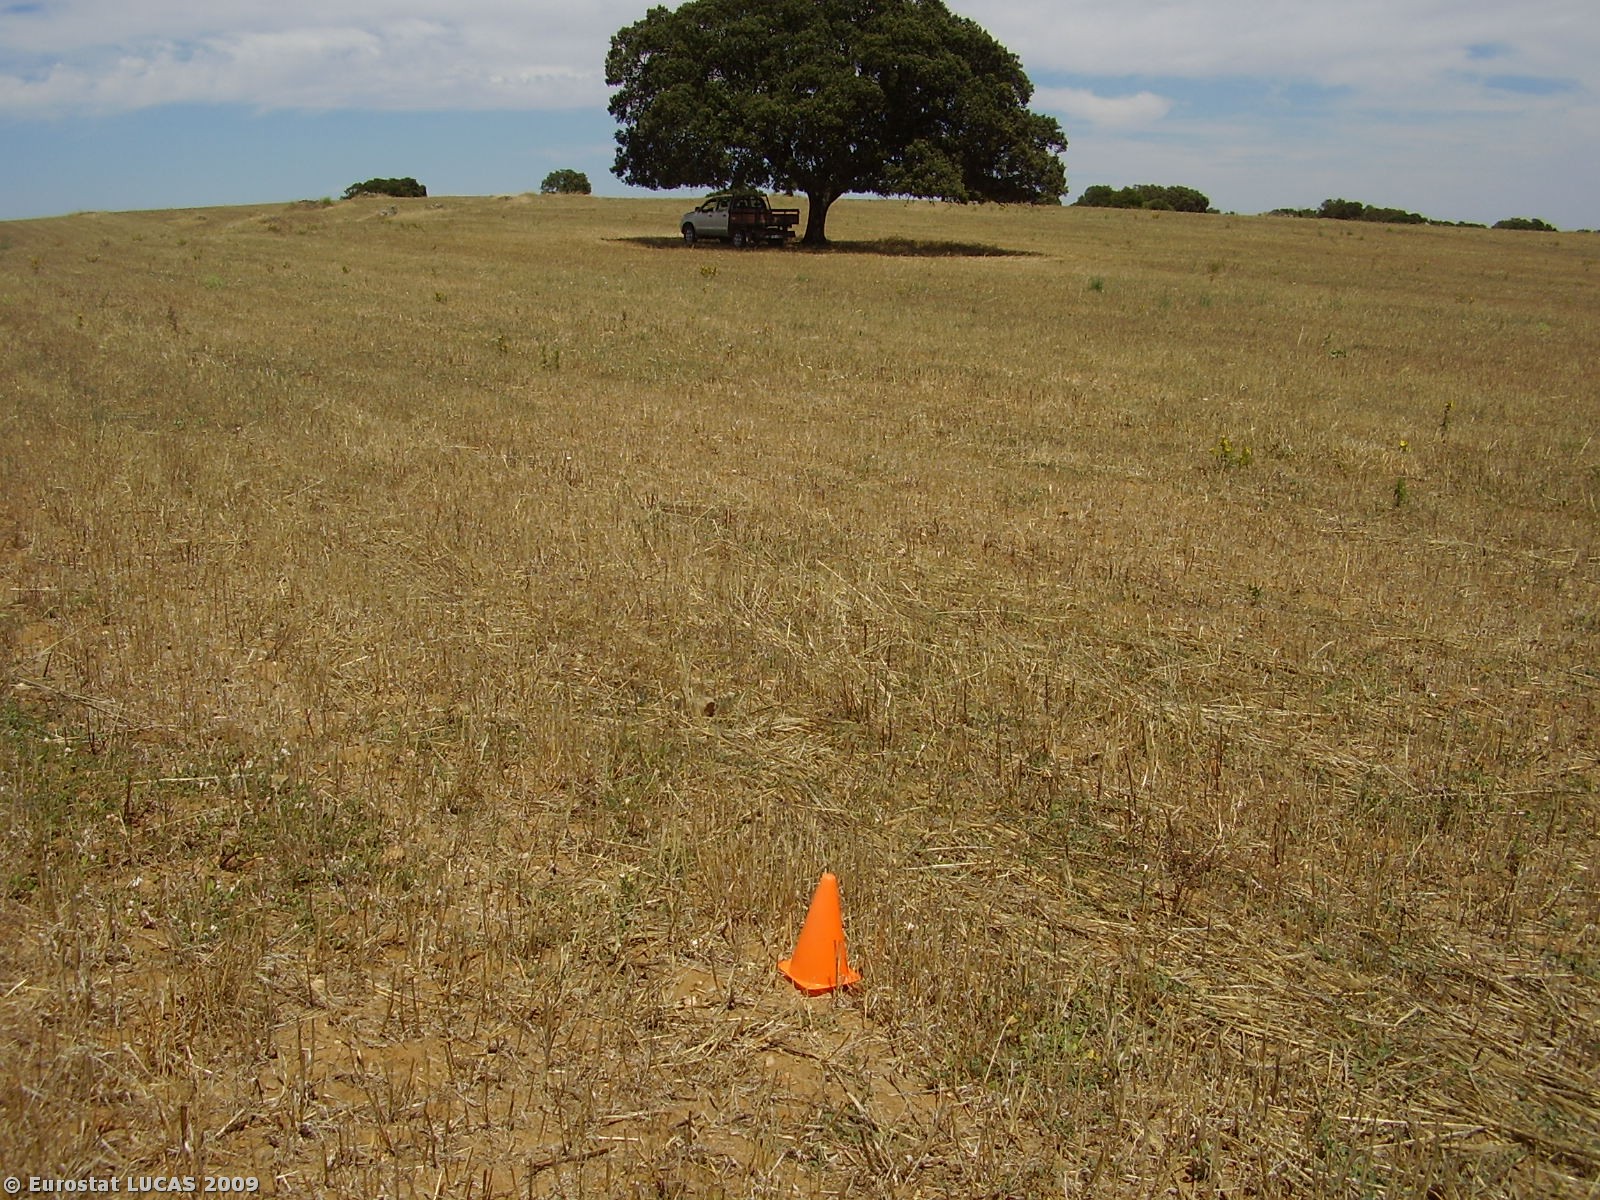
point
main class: Cropland
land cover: Common wheat
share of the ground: > 75 %
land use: Agriculture (excluding fallow land and kitchen gardens)
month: July
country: PT
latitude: 38.6811
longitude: -7.8934
